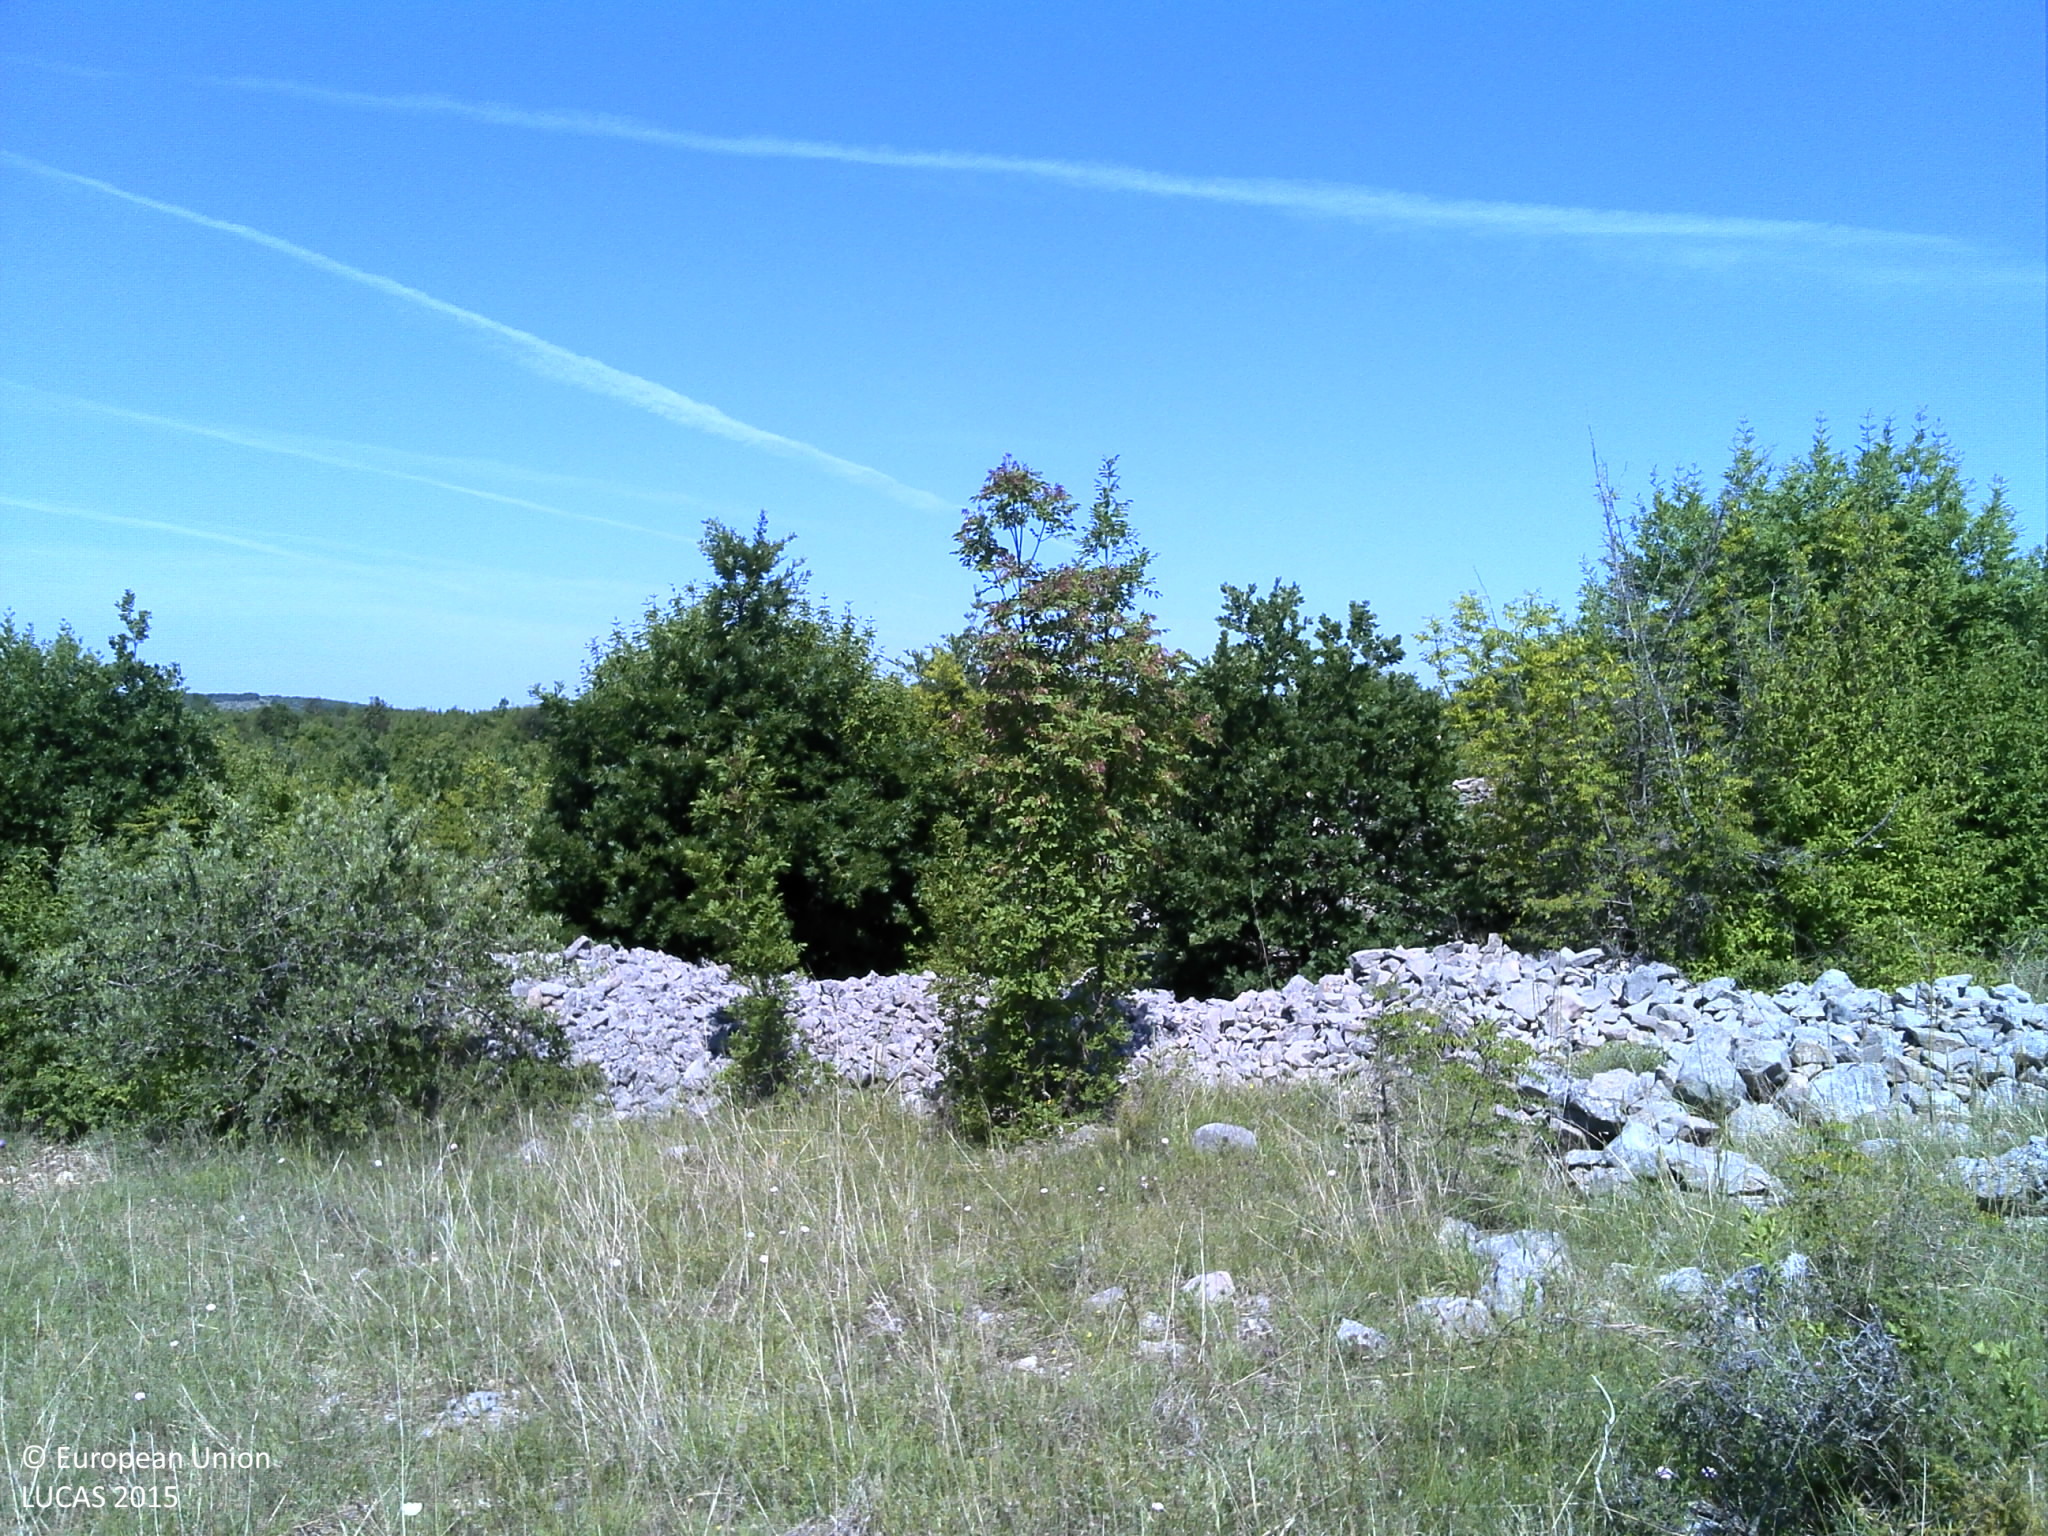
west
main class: Grassland
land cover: Grassland with sparse tree/shrub cover
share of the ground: > 75 %
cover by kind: herbaceous plants 80 %, shrubs 10 %, broadleaved forest trees 5 %, unconsolidated bare surface 5 %
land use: Abandoned areas
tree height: < 5 m
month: June
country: HR
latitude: 43.7498
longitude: 16.1884
